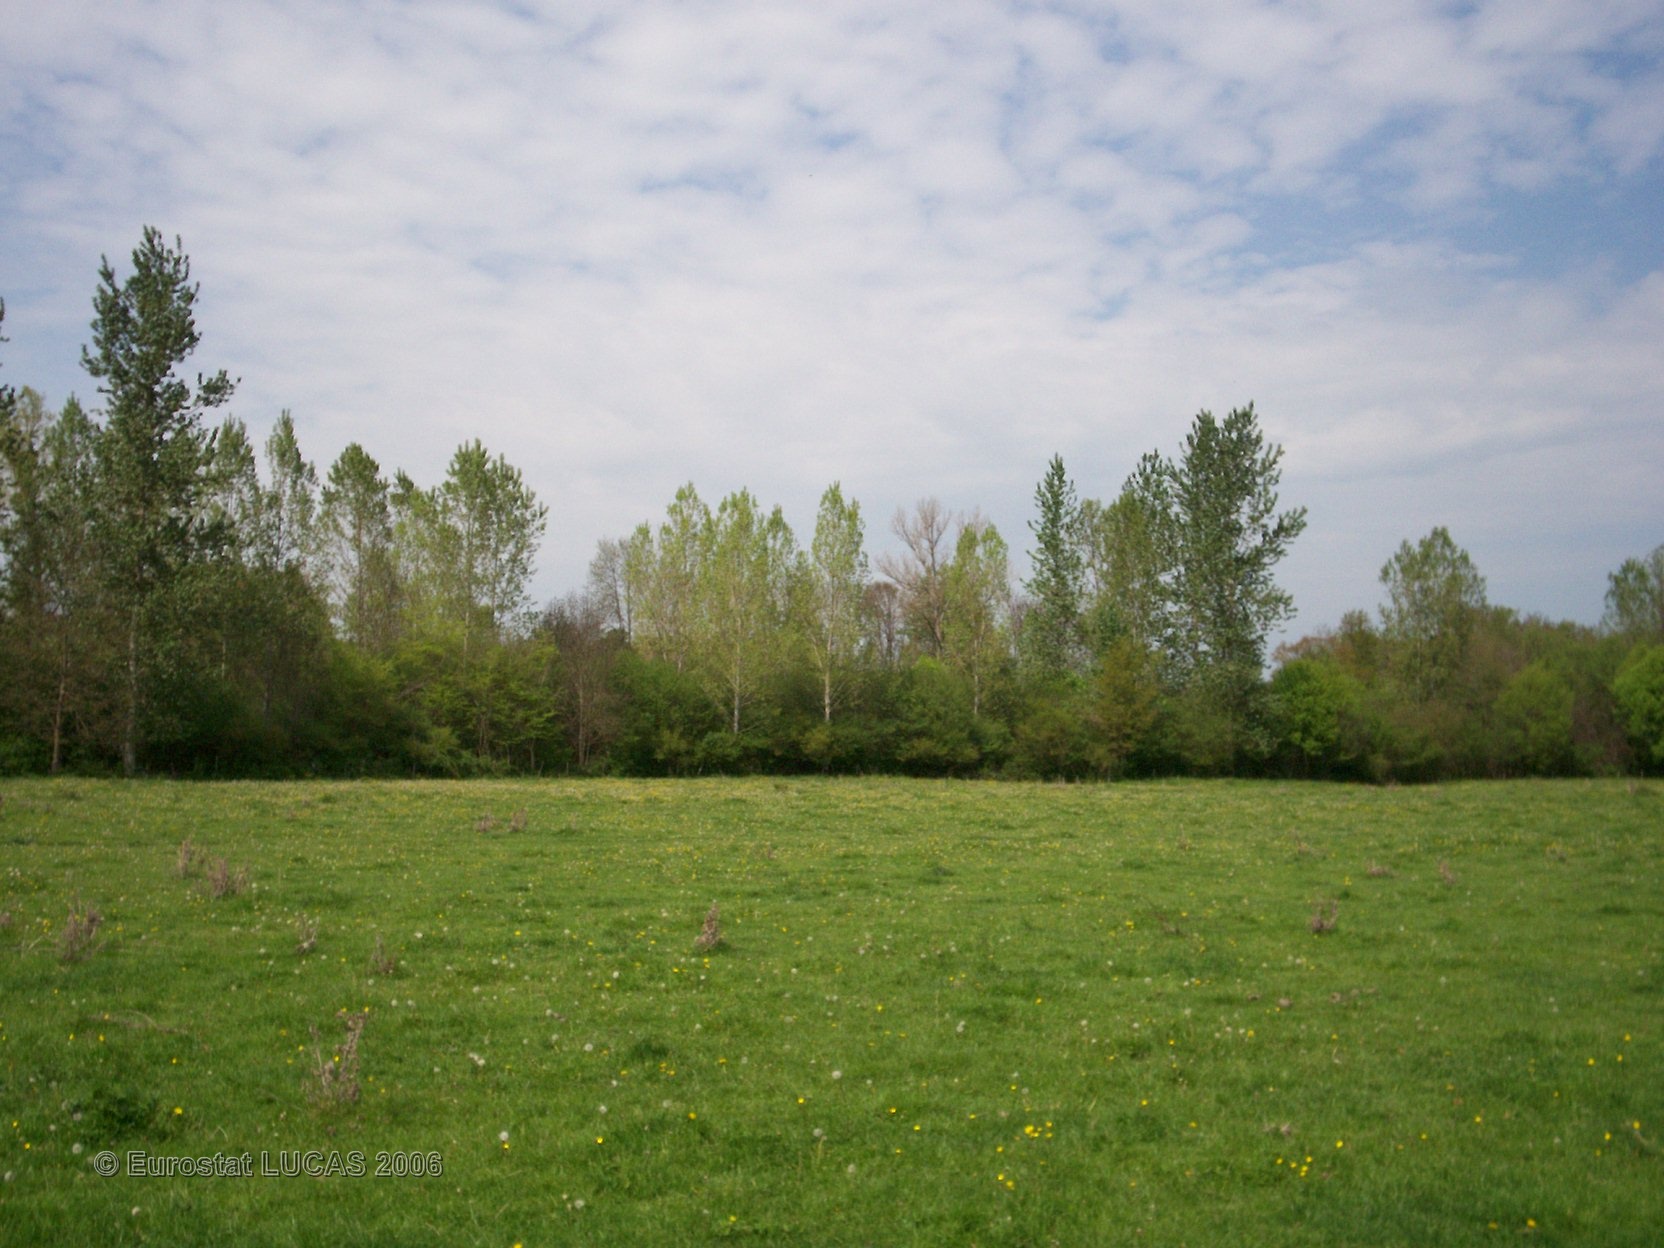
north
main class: Grassland
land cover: Grassland without tree/shrub cover
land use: Agriculture (excluding fallow land and kitchen gardens)
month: May
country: FR
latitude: 45.8282
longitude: 4.1195
